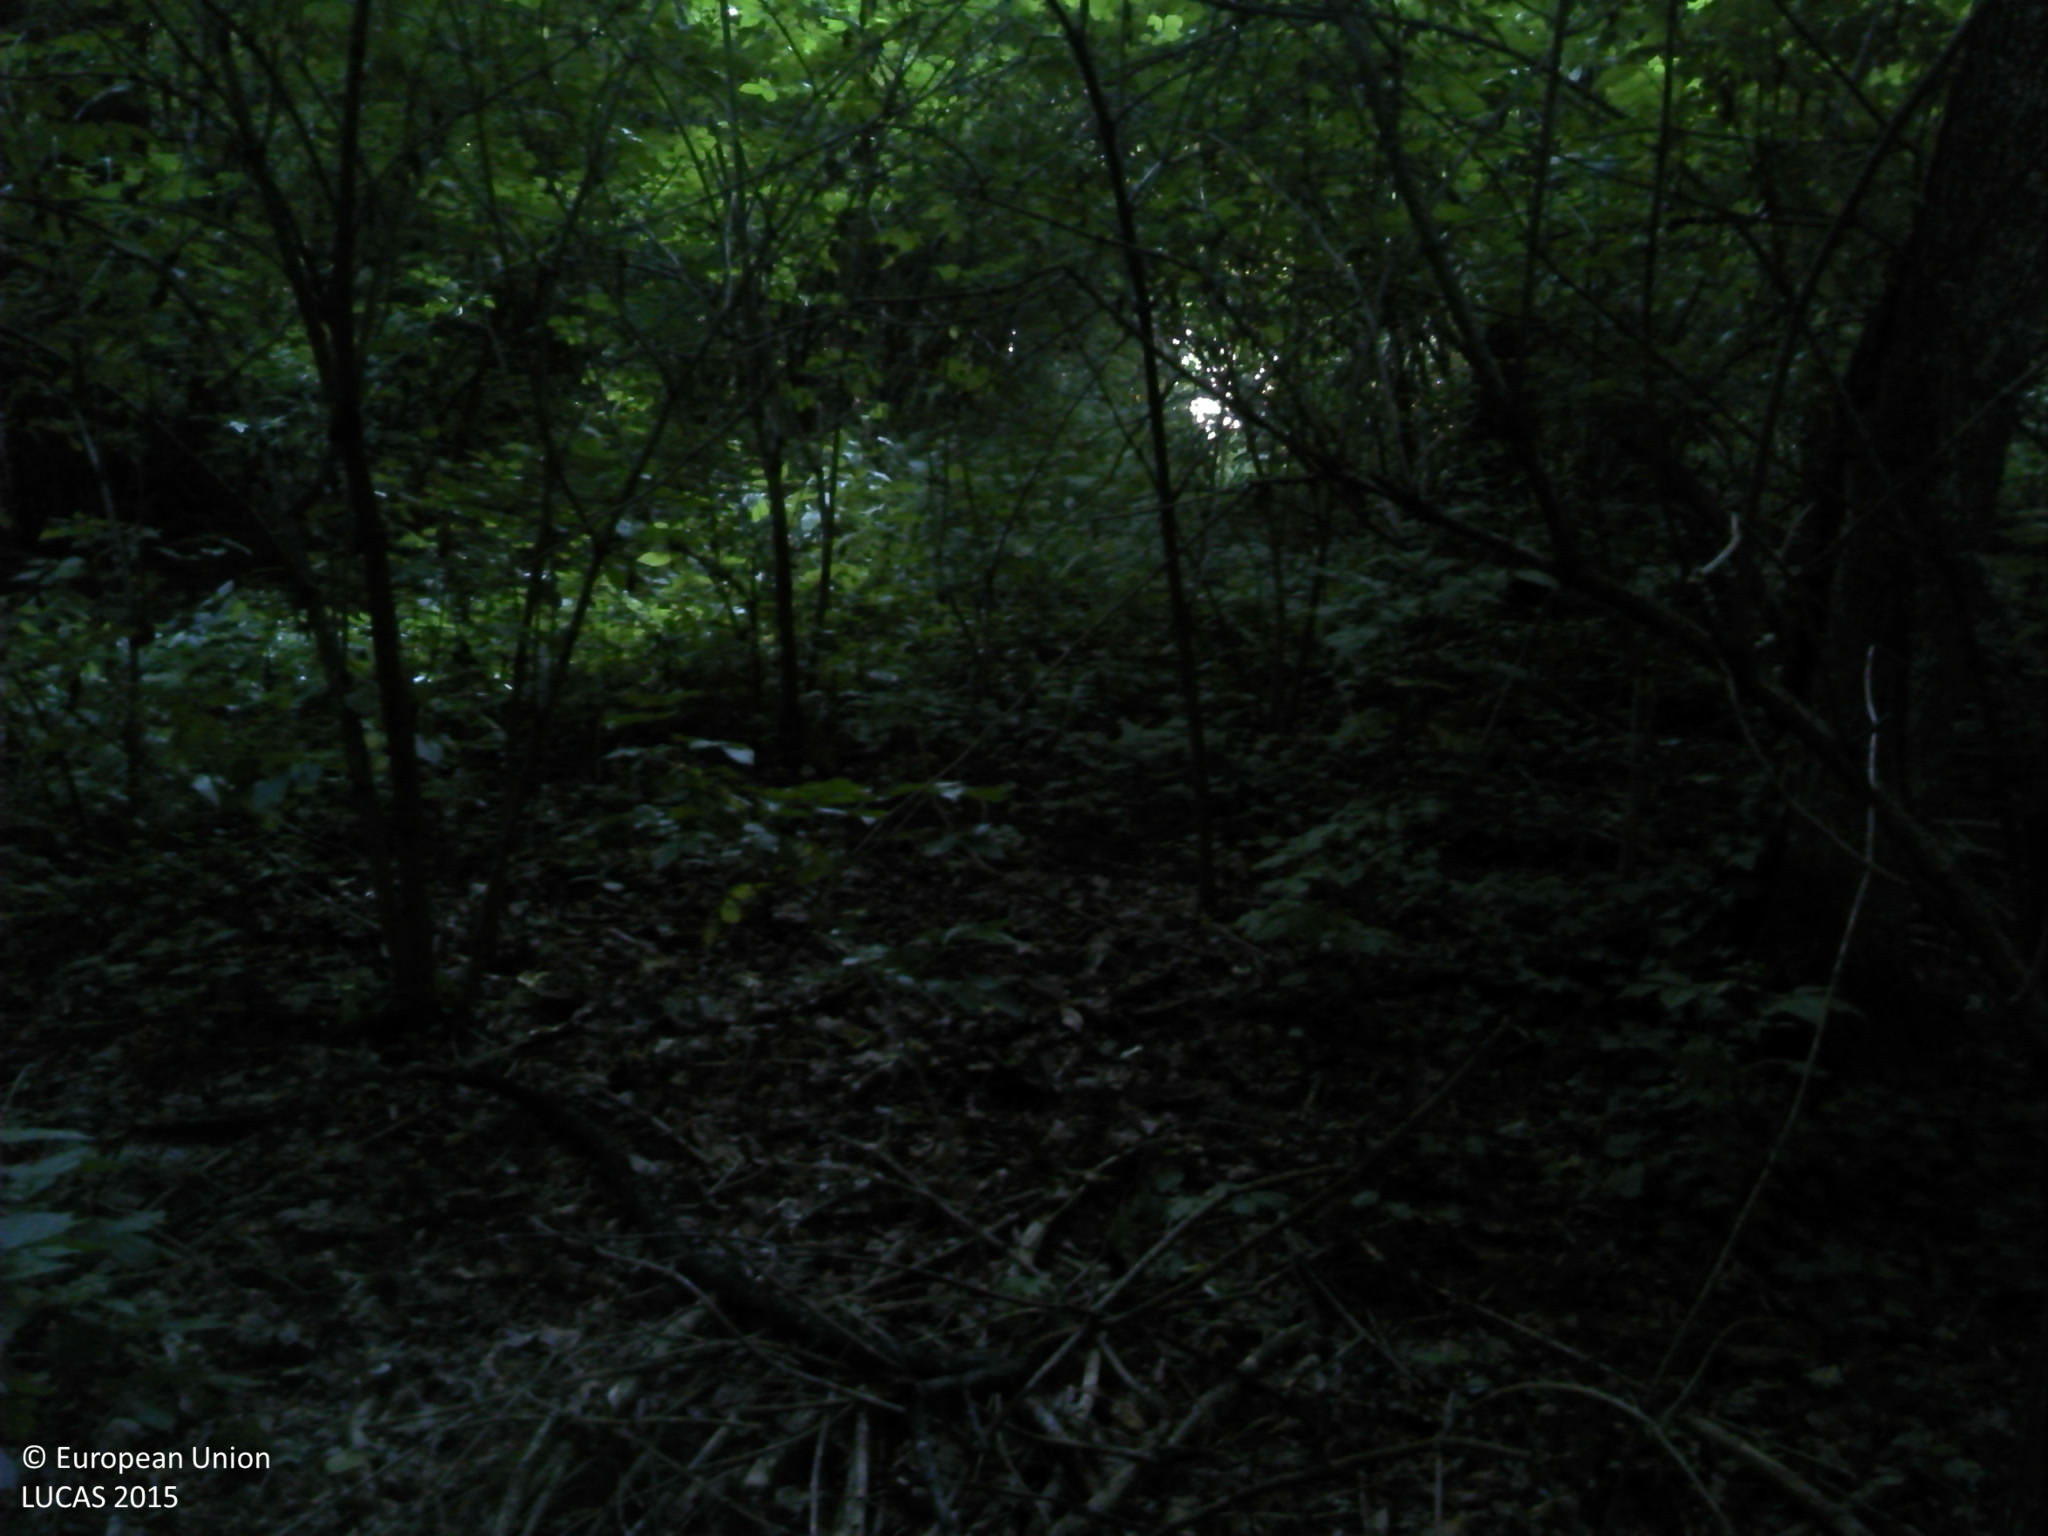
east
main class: Woodland
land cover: Broadleaved woodland
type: mesophytic deciduous forest
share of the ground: > 75 %
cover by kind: broadleaved forest trees 90 %, shrubs 5 %, herbaceous plants 5 %
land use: Forestry
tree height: > 5 m
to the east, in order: Broadleaved woodland; Temporary grasslands
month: July
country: HR
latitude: 45.8757
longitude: 16.8933
